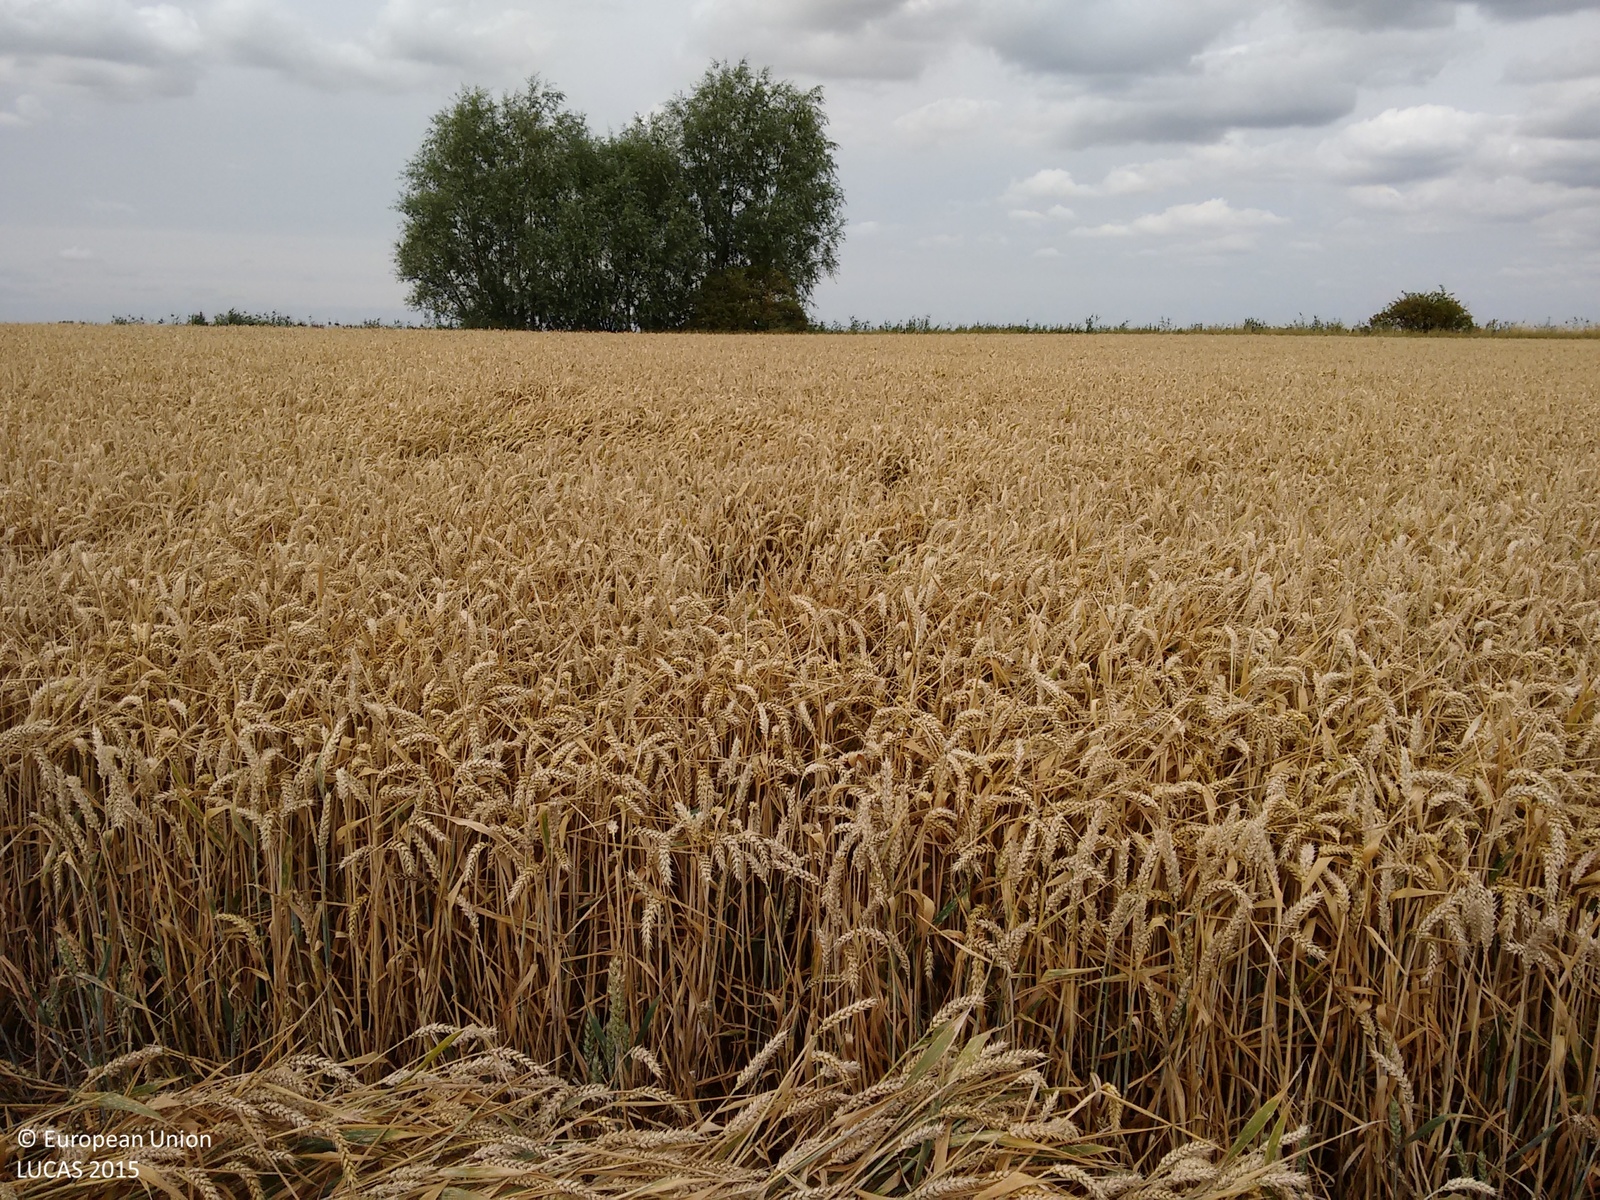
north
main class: Cropland
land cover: Common wheat
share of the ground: > 75 %
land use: Agriculture (excluding fallow land and kitchen gardens)
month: August
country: GB
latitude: 52.4861
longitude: 0.2954
